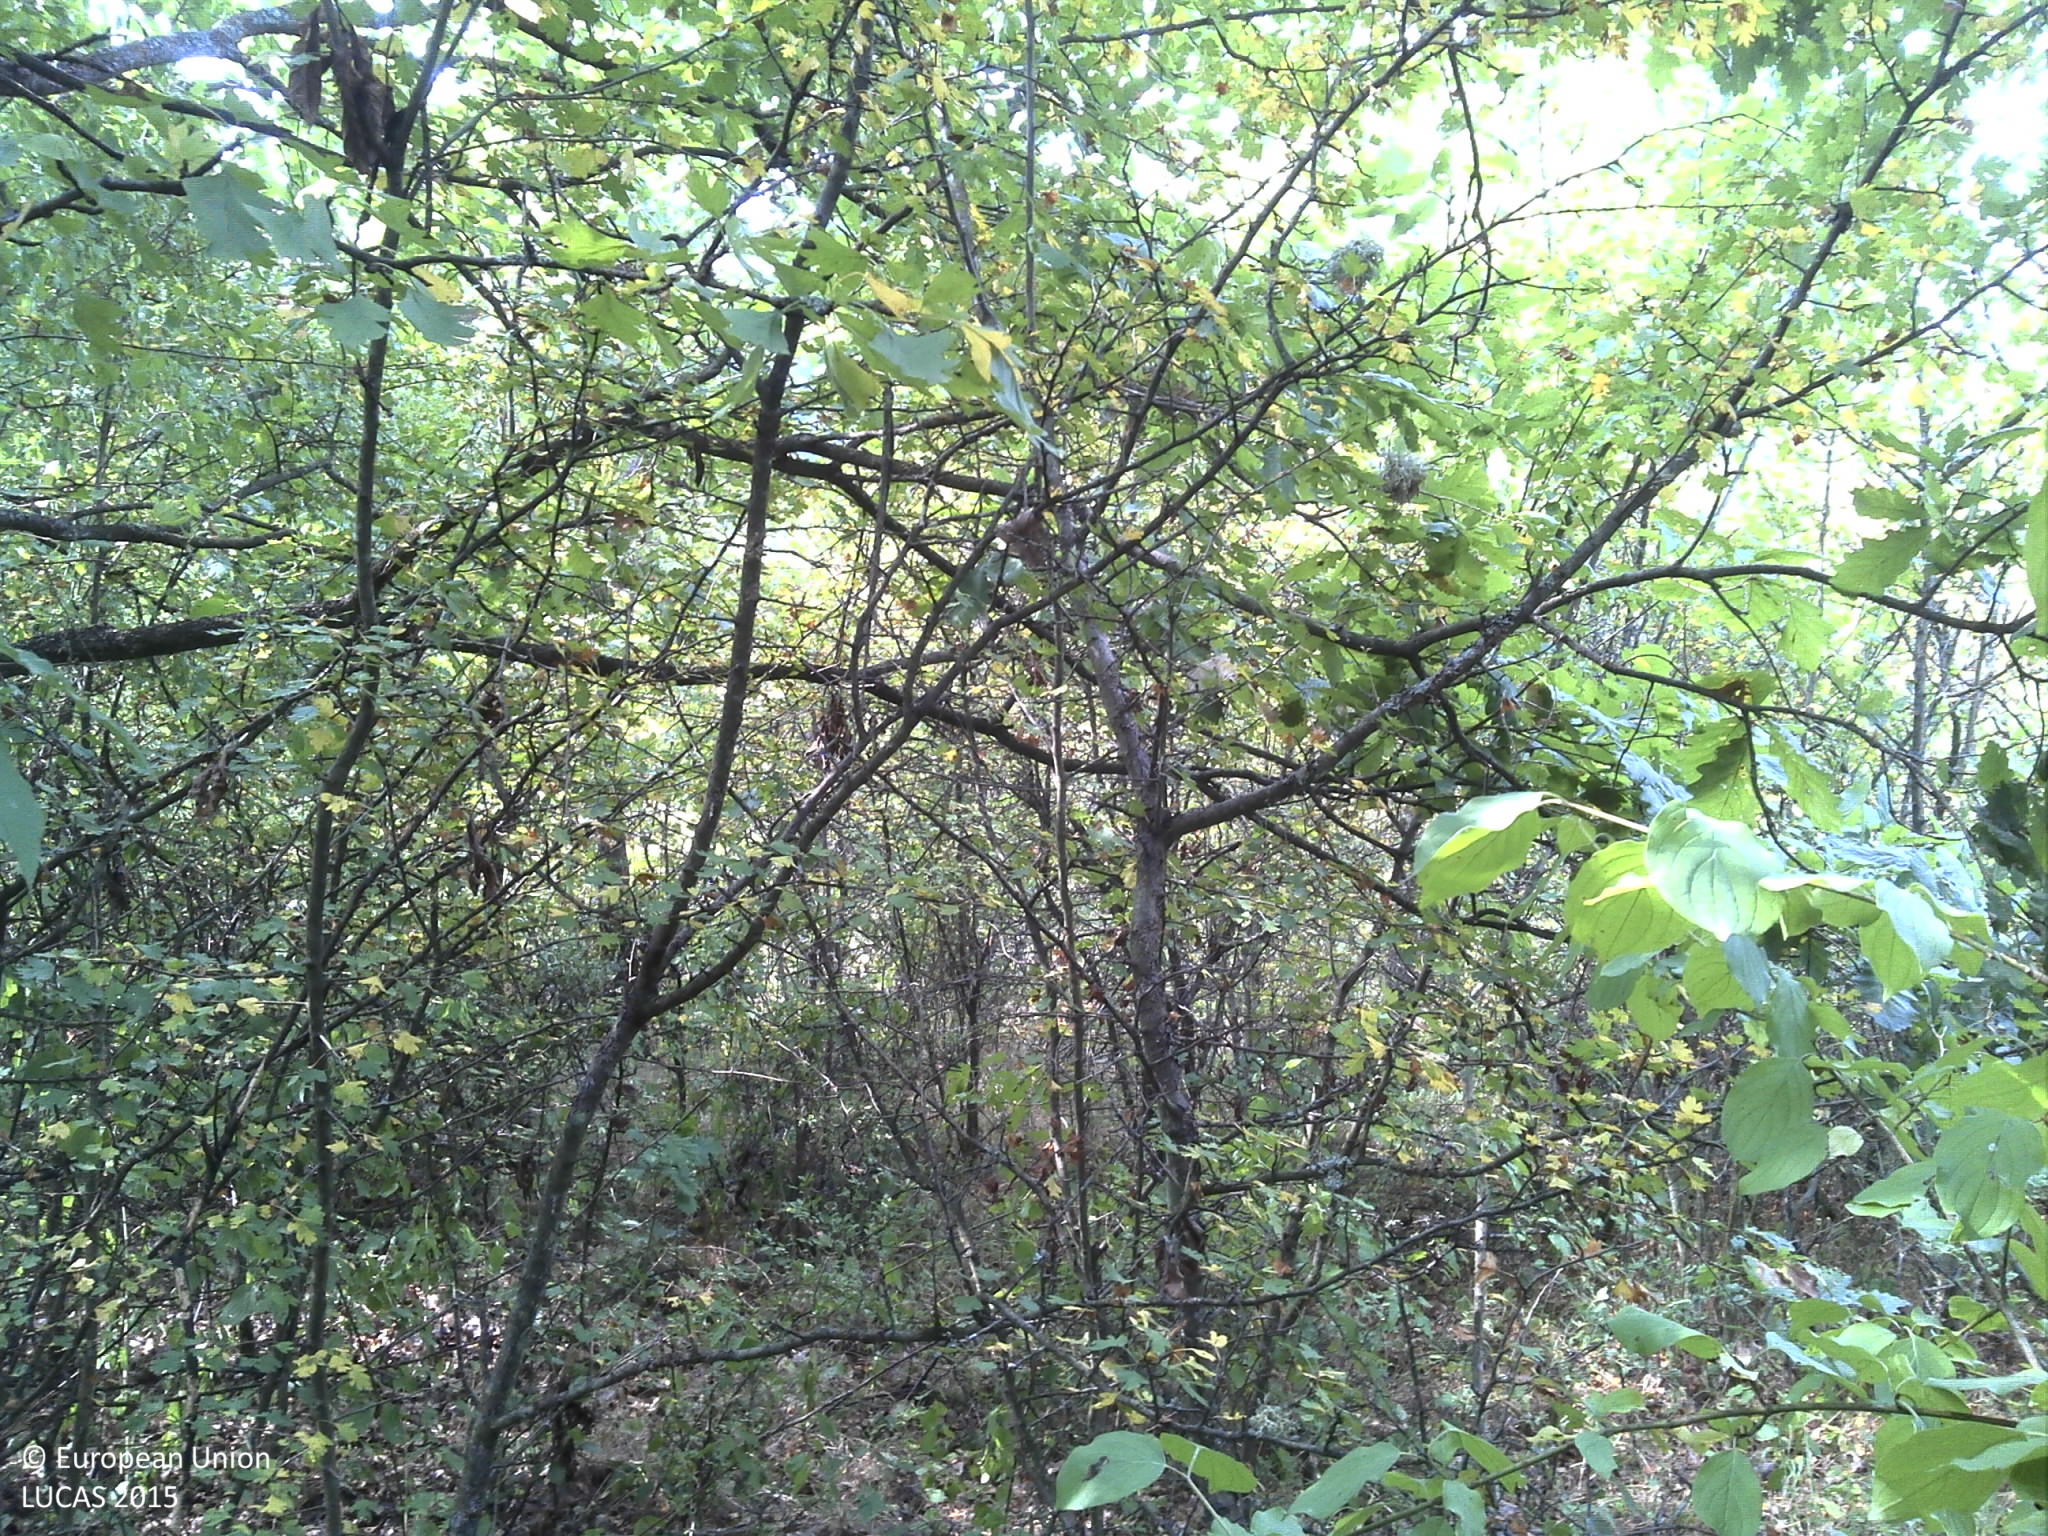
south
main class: Shrubland
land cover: Shrubland with sparse tree cover
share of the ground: > 75 %
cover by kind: shrubs 95 %, broadleaved forest trees 5 %
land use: Semi-natural and natural areas not in use
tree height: < 5 m
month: August
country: HR
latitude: 45.2935
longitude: 18.2029
